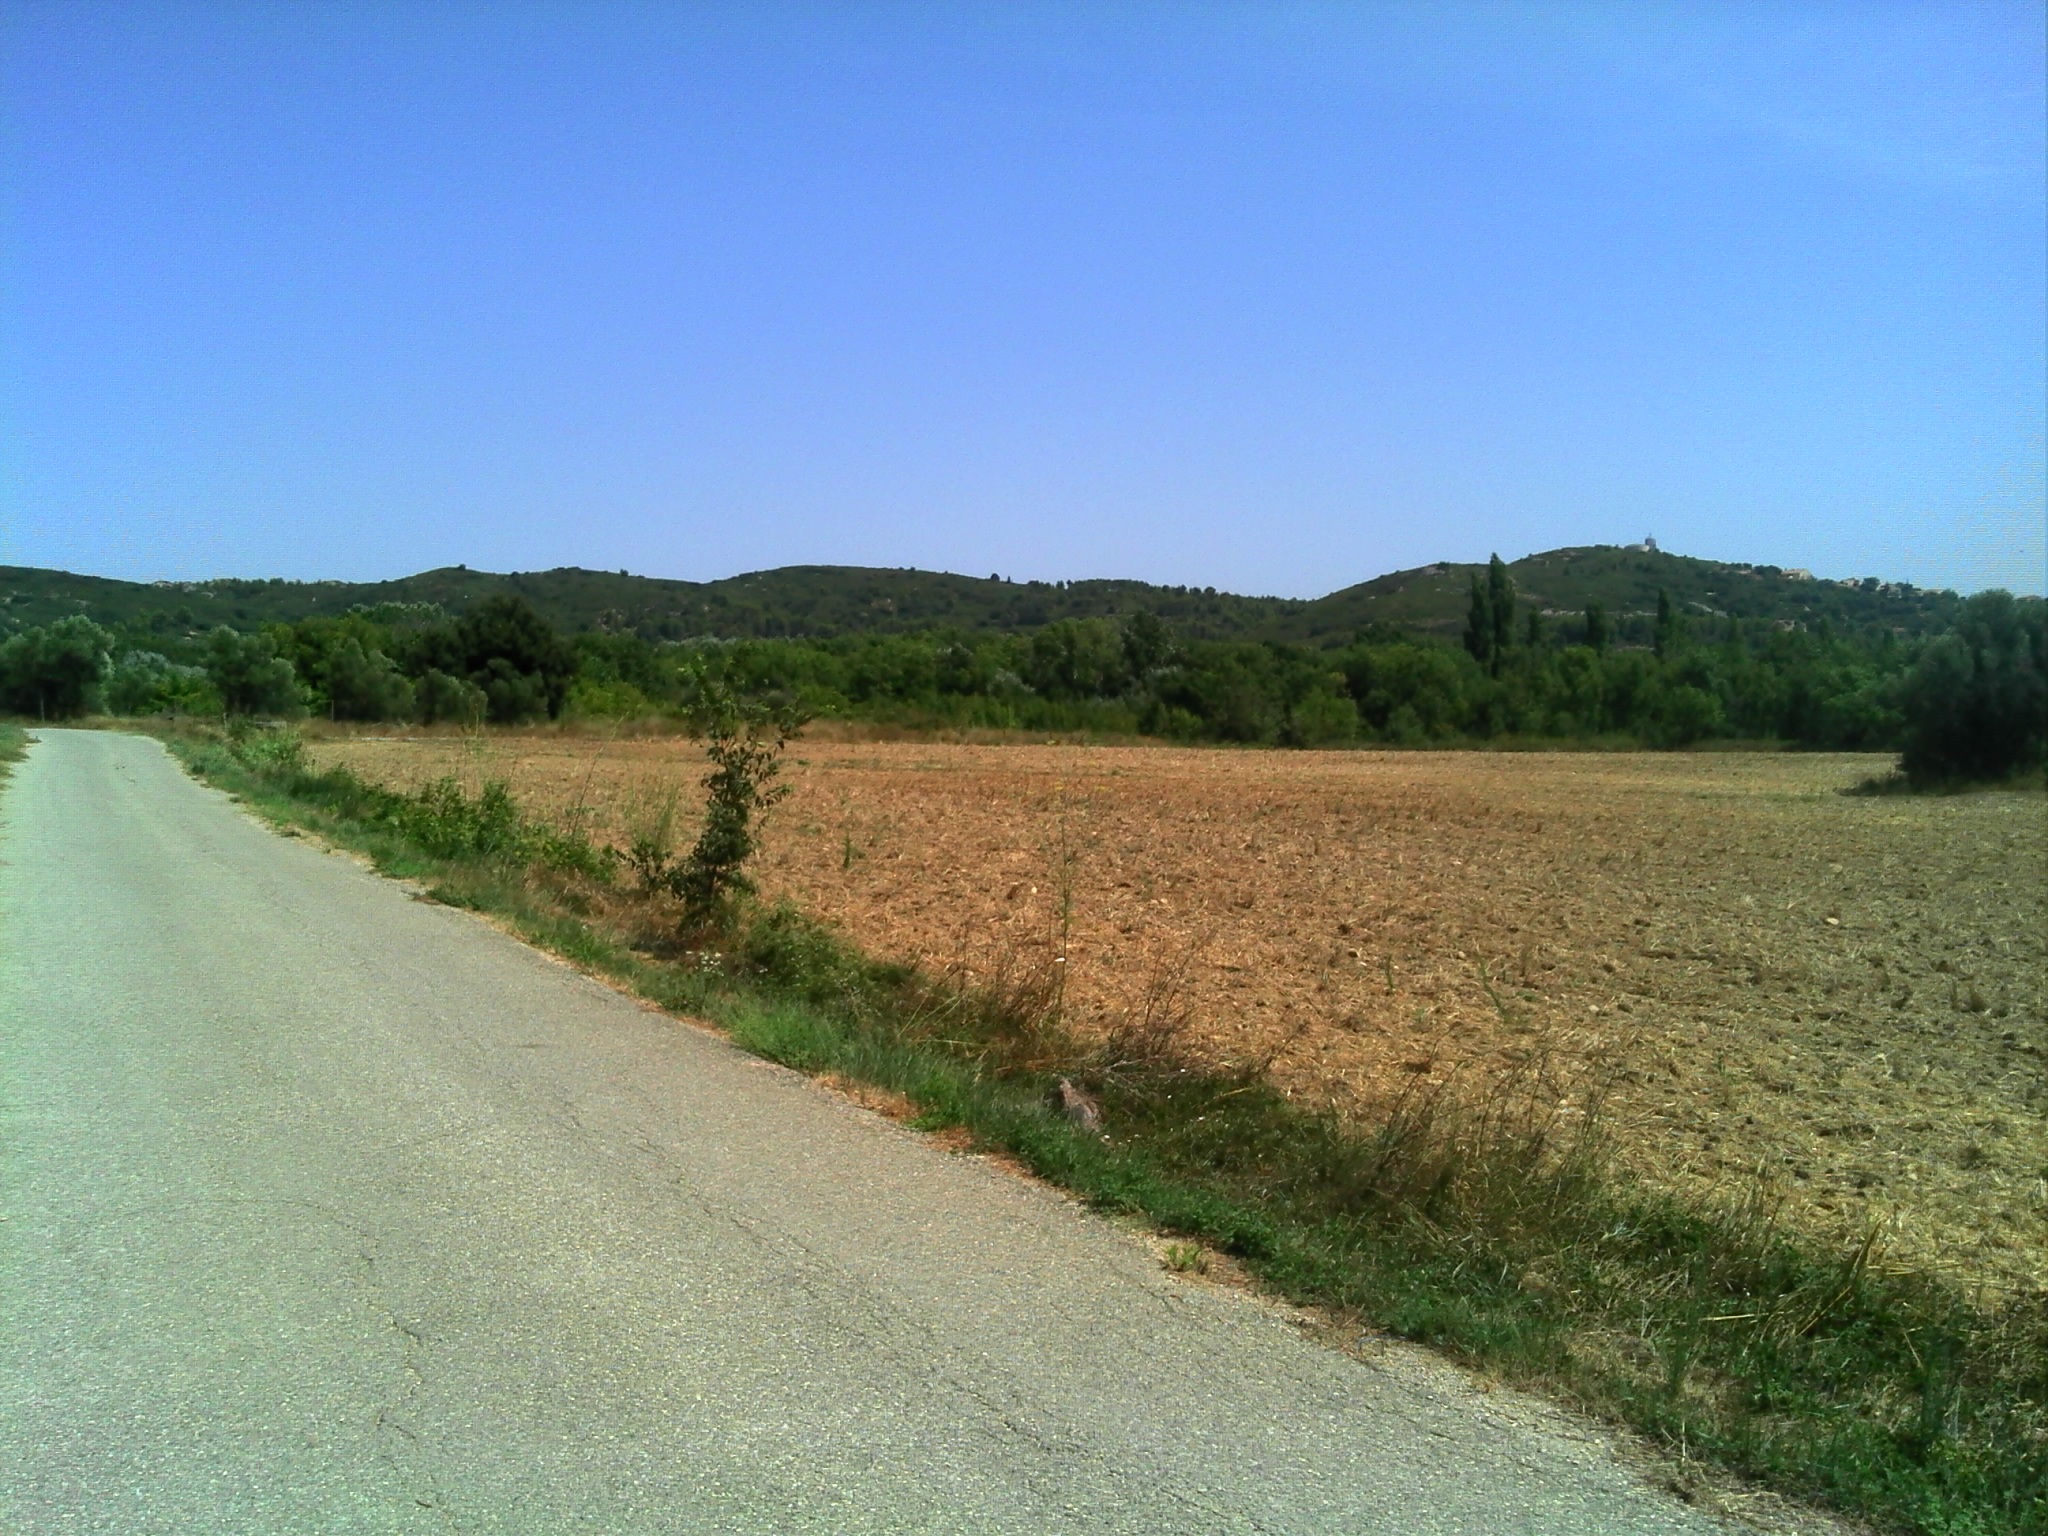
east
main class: Shrubland
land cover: Shrubland with sparse tree cover
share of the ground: > 75 %
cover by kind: herbaceous plants 50 %, shrubs 40 %, broadleaved forest trees 5 %, consolidated bare surface 5 %
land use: Semi-natural and natural areas not in use
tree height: < 5 m
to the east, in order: Grass margins; Paved roads, cycling and walking lanes; Grass margins; Other bare soil; Grass margins; Tracks; Spontaneously vegetated surfaces; Tracks; Fences; Grassland without tree/shrub cover; Fences; Grassland without tree/shrub cover; Fences; Lines of trees; Spontaneously vegetated surfaces; Broadleaved woodland
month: August
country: FR
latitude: 43.9062
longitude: 4.6671
